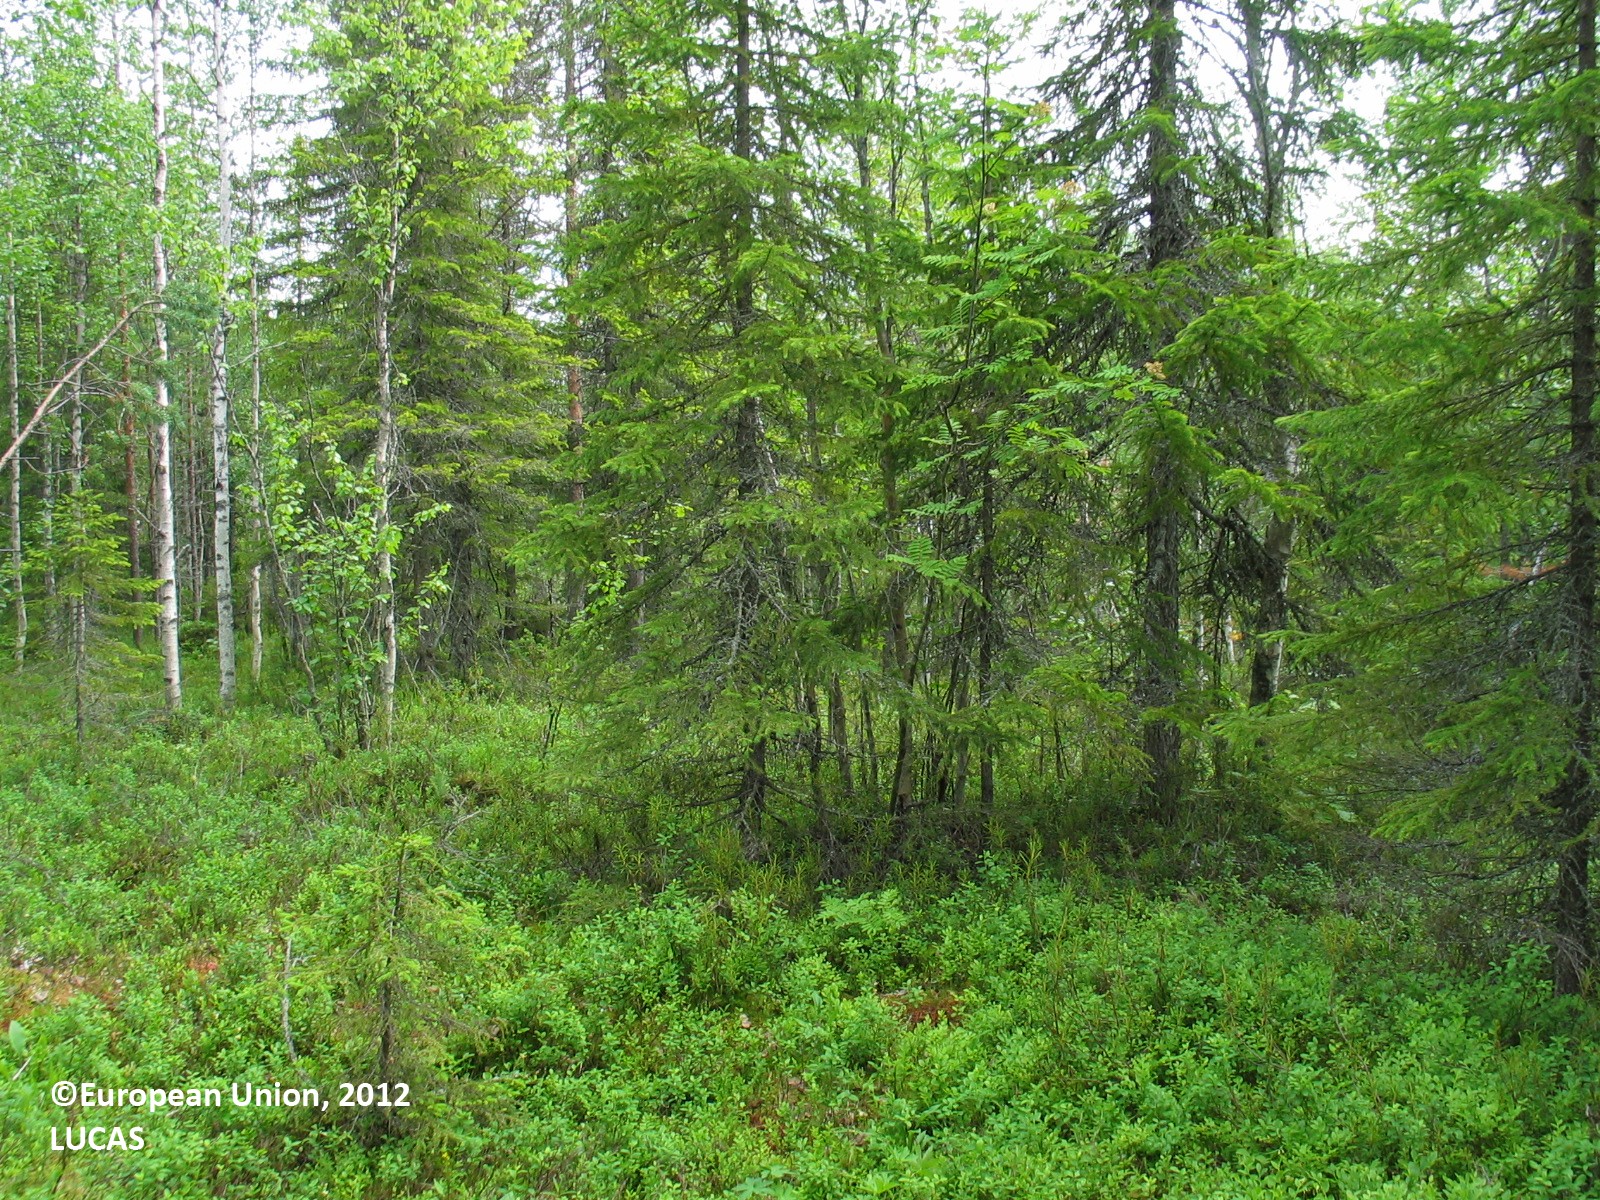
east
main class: Woodland
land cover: Other mixed woodland
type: mire and swamp forests
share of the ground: 25 - 50 %
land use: Forestry
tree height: > 5 m
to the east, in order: Other mixed woodland; Pine dominated coniferous woodland; Other mixed woodland; Ditches and canals; Other mixed woodland; Pine dominated coniferous woodland; Peatbogs; Pine dominated coniferous woodland; Other mixed woodland; Ditches and canals; Other mixed woodland; Pine dominated coniferous woodland; Other mixed woodland; Ditches and canals; Other mixed woodland
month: July
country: FI
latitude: 66.0442
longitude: 25.4079
